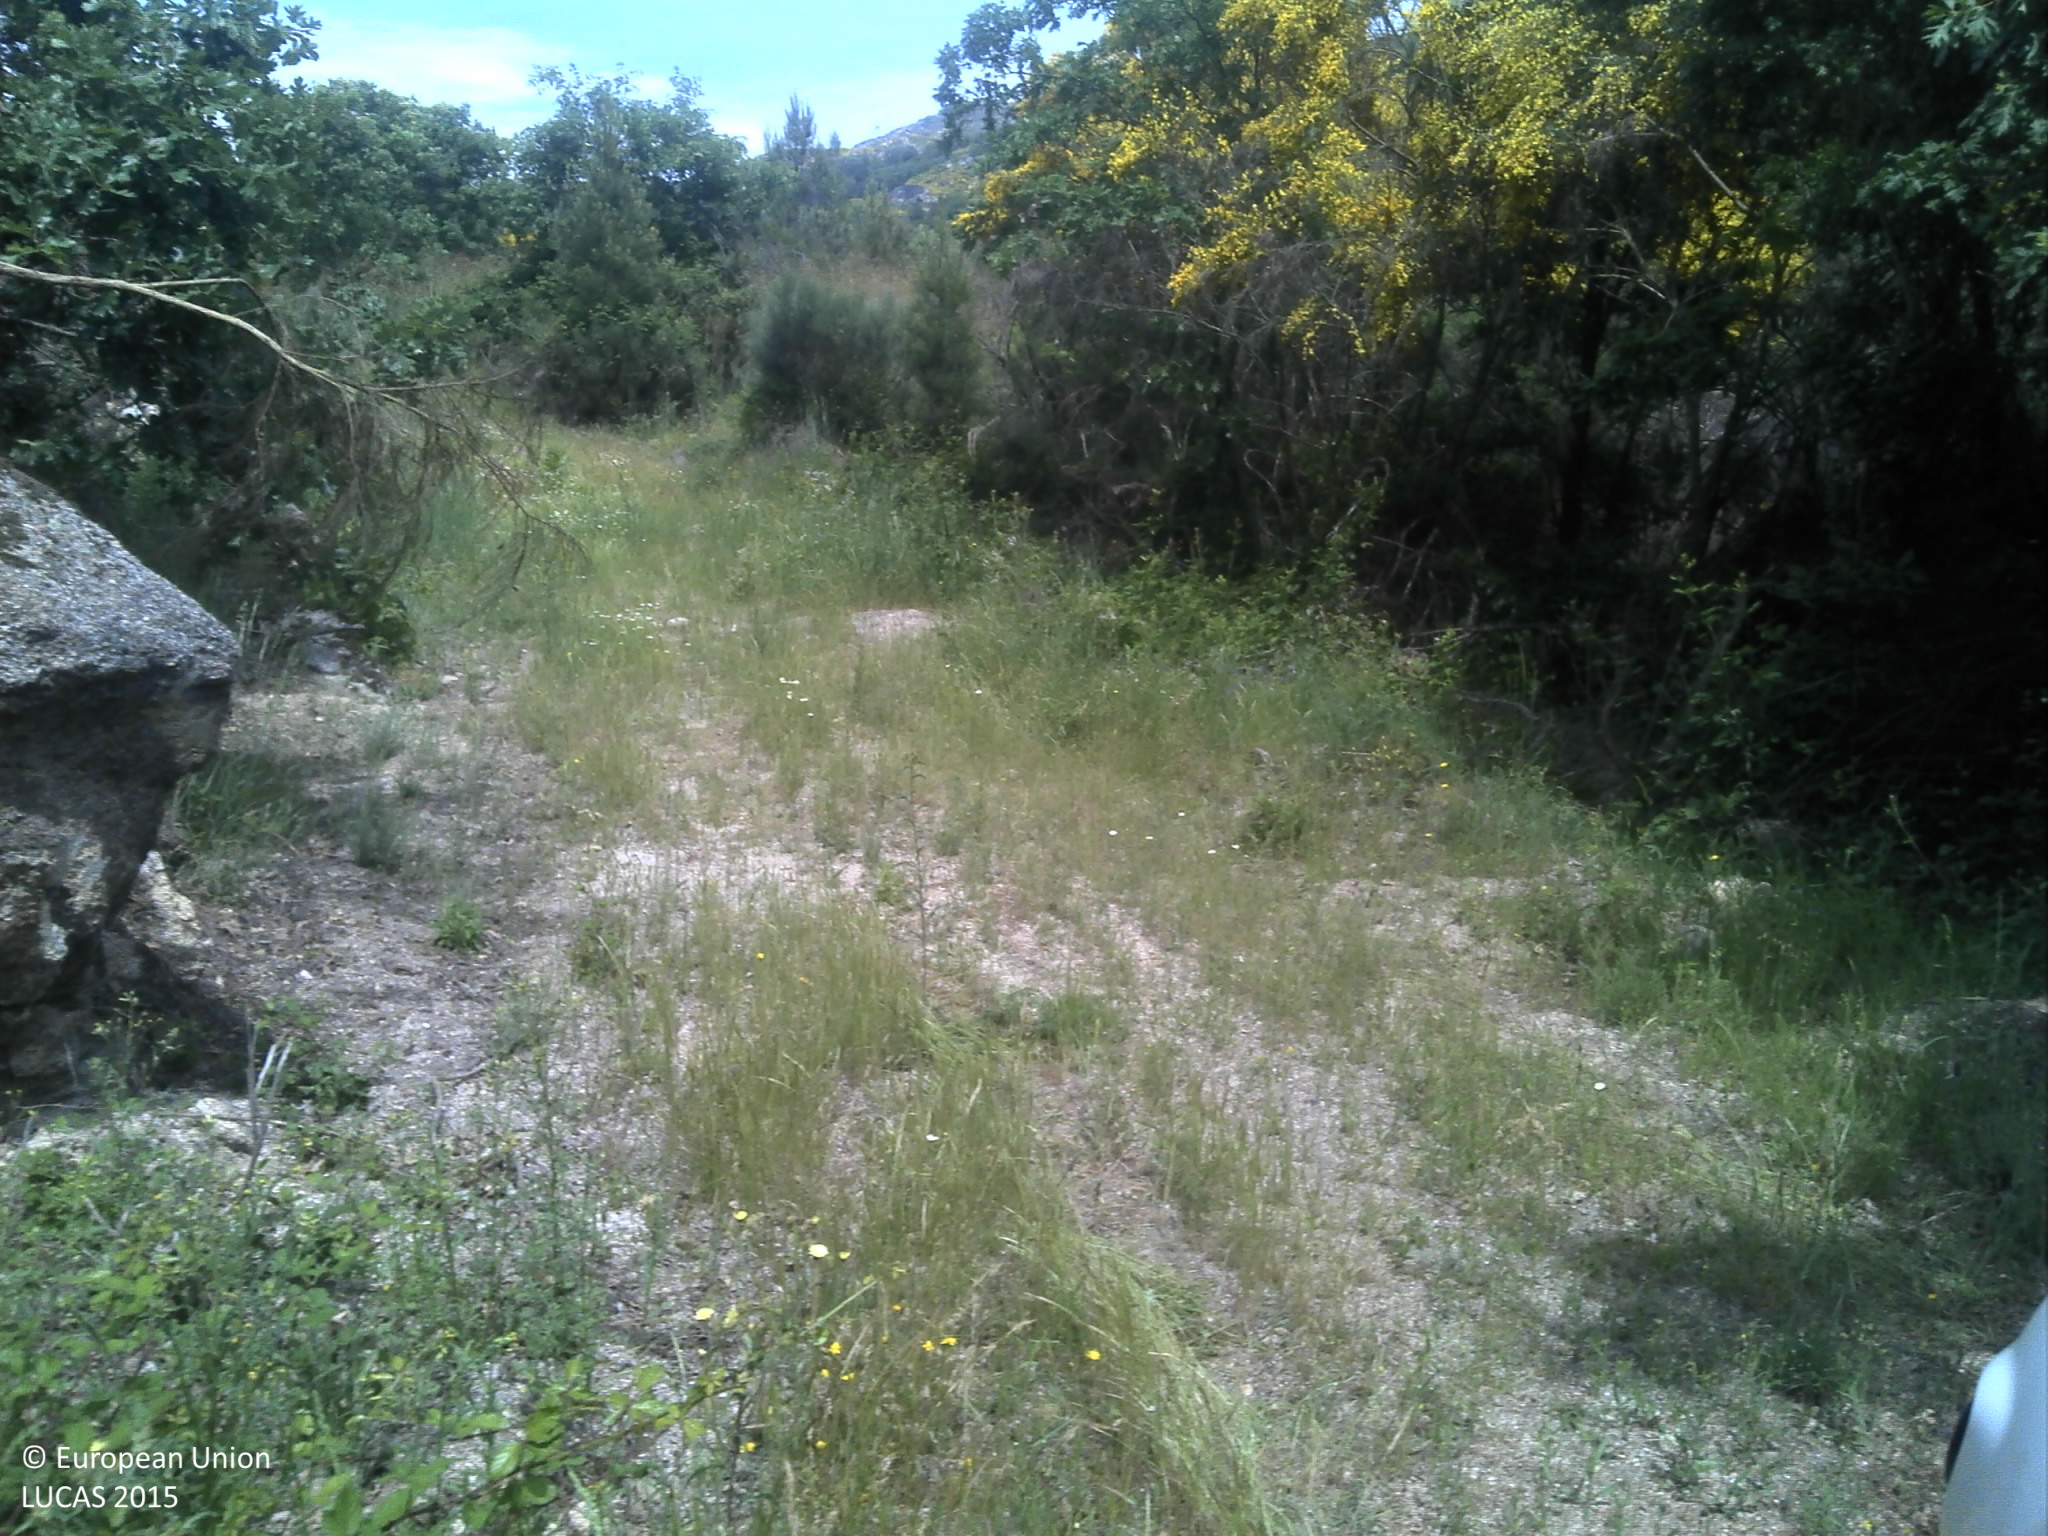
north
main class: Shrubland
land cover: Shrubland with sparse tree cover
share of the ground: 50 - 75 %
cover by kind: shrubs 70 %, unconsolidated bare surface 10 %, broadleaved forest trees 5 %, herbaceous plants 5 %
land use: Semi-natural and natural areas not in use
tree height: > 5 m
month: May
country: PT
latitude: 40.7226
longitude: -7.4335
